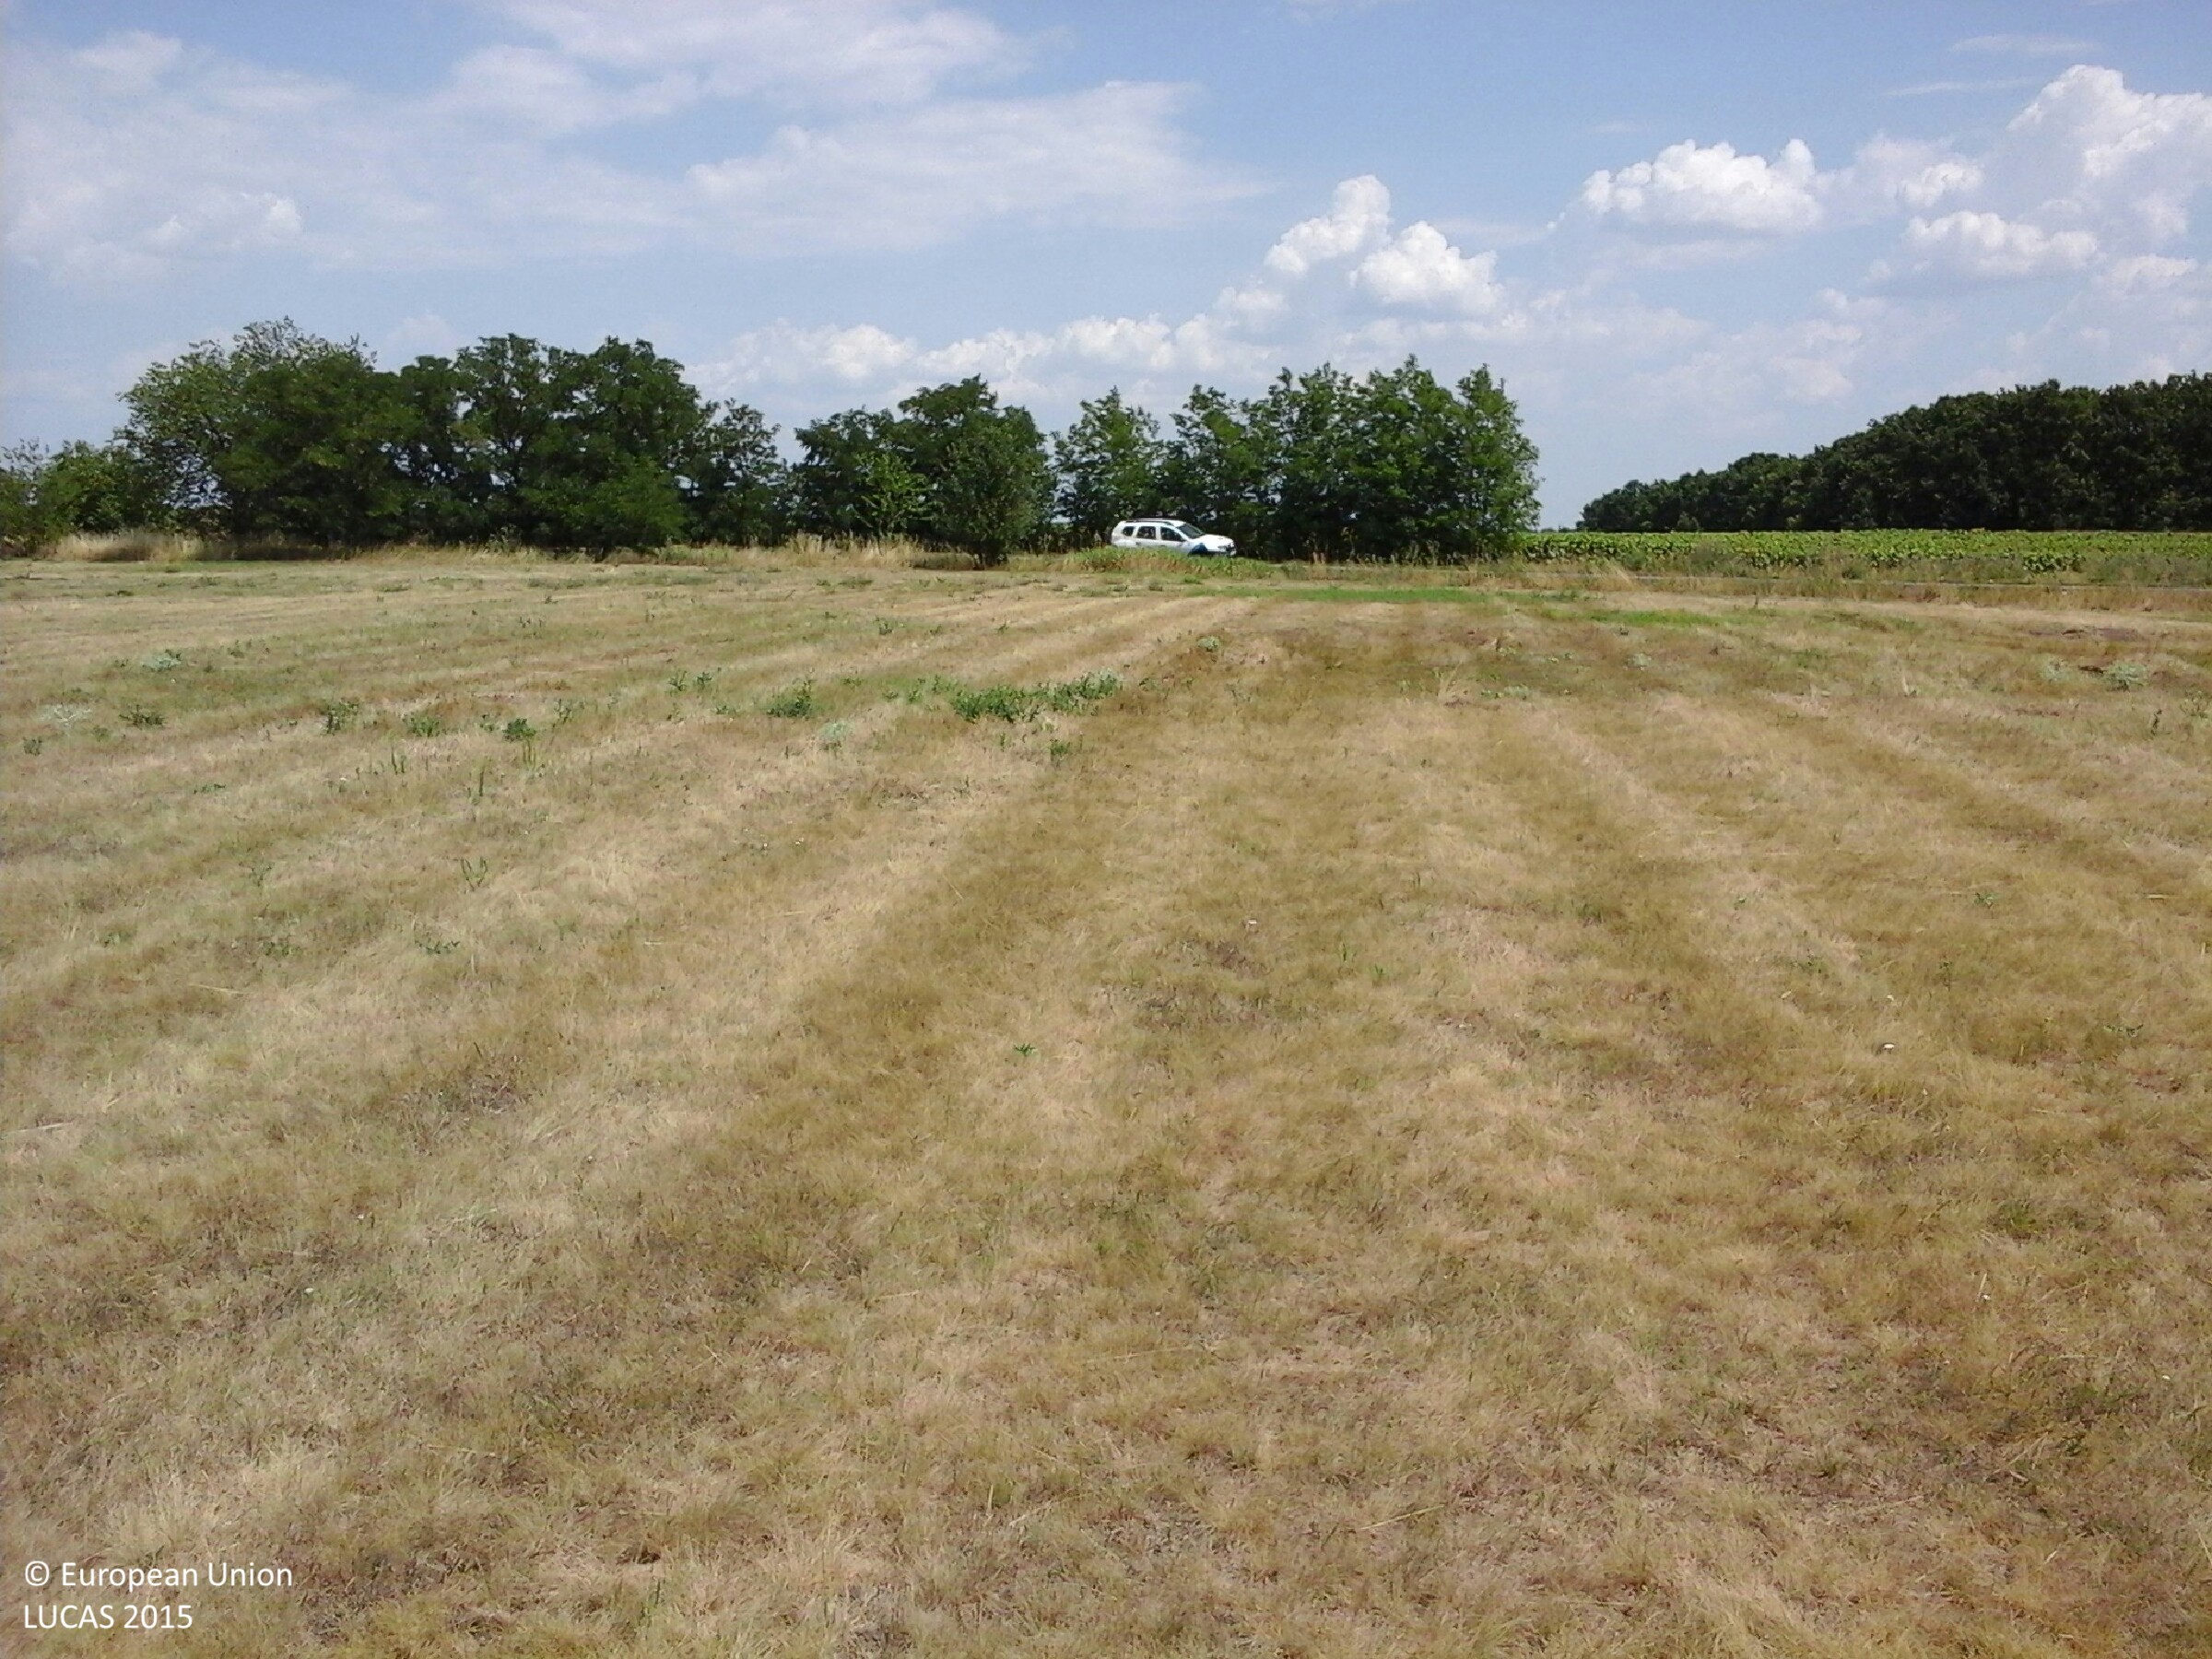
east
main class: Grassland
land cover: Grassland without tree/shrub cover
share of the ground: > 75 %
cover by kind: herbaceous plants 100 %
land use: Agriculture (excluding fallow land and kitchen gardens)
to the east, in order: Grassland without tree/shrub cover; Electric lines; Grassland without tree/shrub cover; Ditches and canals; Paved roads, cycling and walking lanes; Ditches and canals; Abandoned hedges; Sunflower
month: July
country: HU
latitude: 47.6878
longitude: 20.6516
